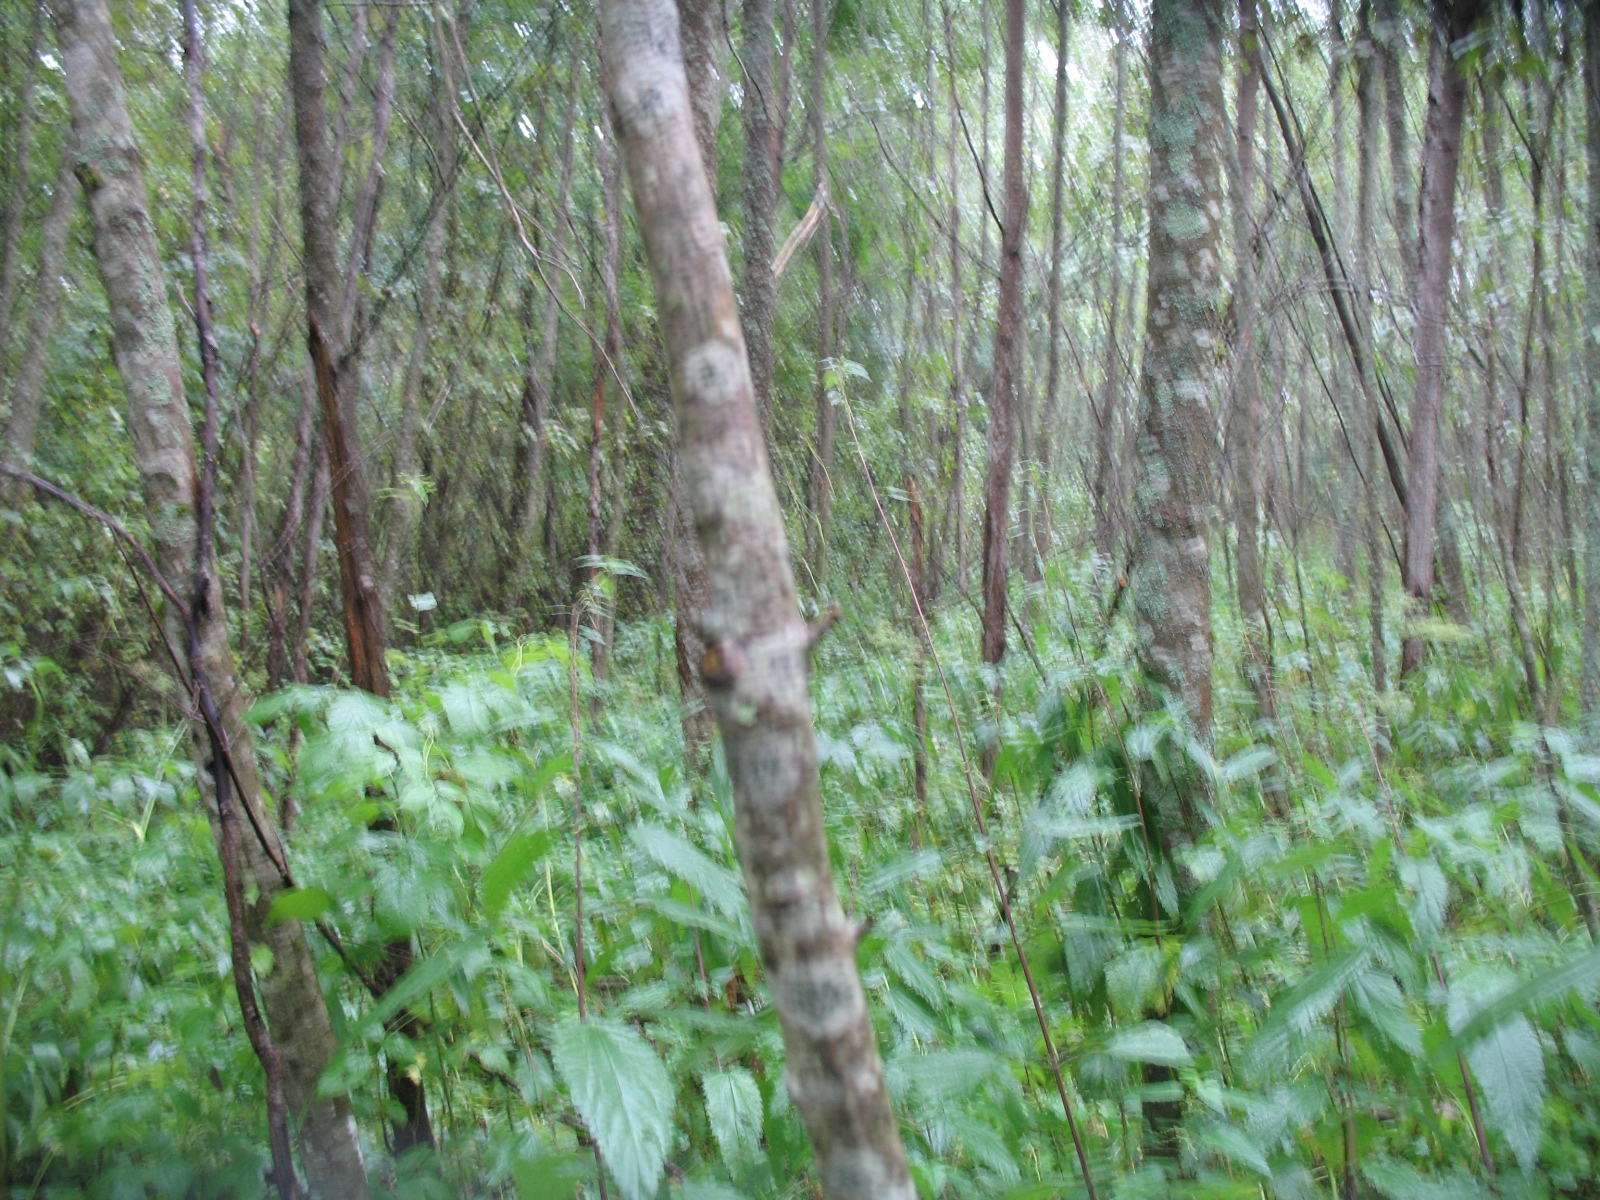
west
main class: Woodland
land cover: Broadleaved woodland
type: non-riverine alder, birch or aspen forest
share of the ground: > 75 %
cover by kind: broadleaved forest trees 90 %, herbaceous plants 10 %
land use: Forestry
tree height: > 5 m
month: September
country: LV
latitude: 56.0230
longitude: 25.9706
